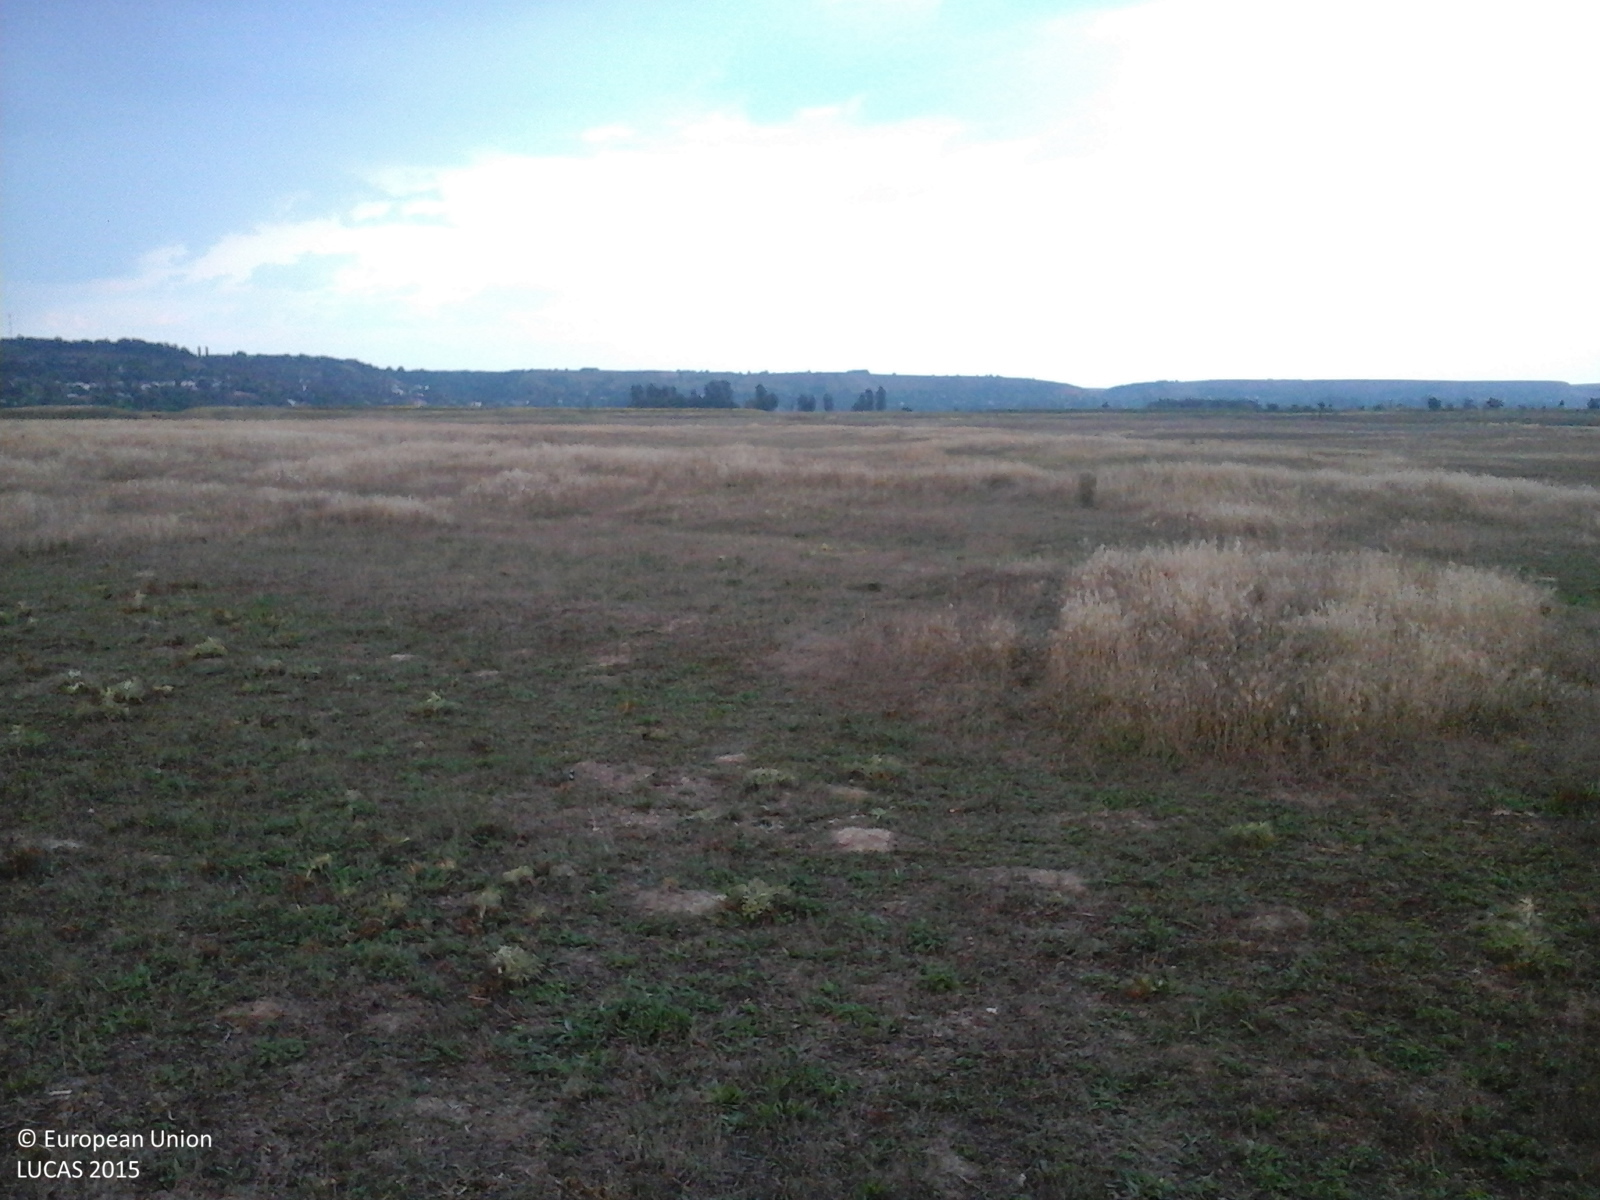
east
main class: Grassland
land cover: Grassland without tree/shrub cover
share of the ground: > 75 %
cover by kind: herbaceous plants 100 %
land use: Agriculture (excluding fallow land and kitchen gardens)
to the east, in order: Grassland without tree/shrub cover; Tracks; Grassland without tree/shrub cover
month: July
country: RO
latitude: 43.8837
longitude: 24.6938
